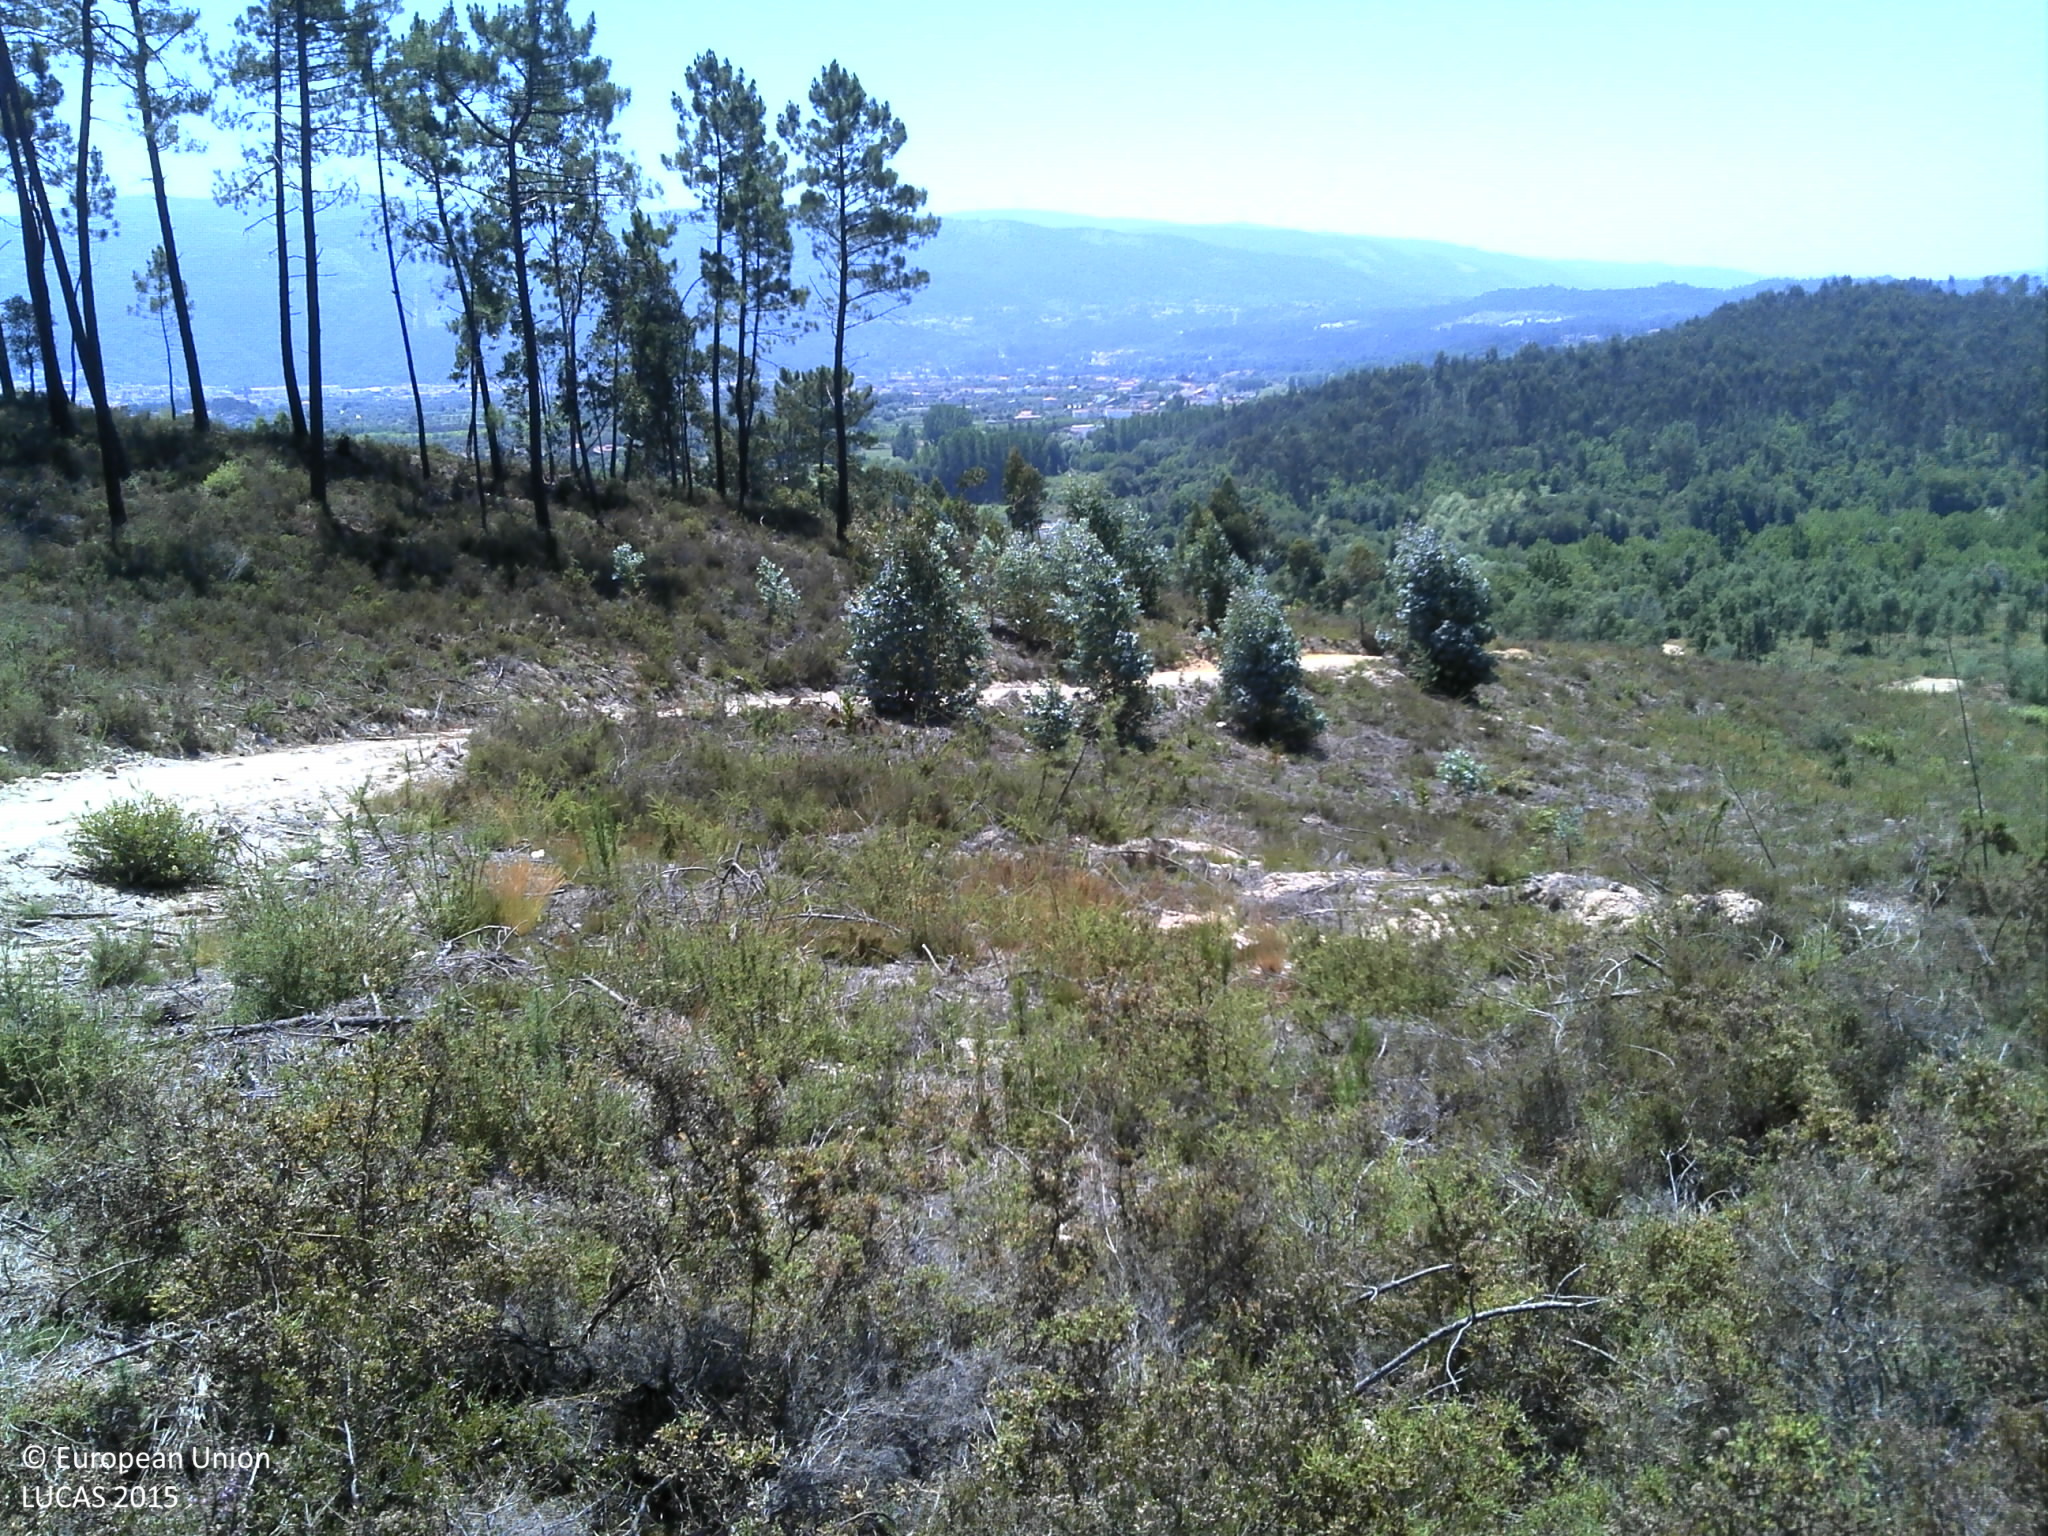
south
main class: Shrubland
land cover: Shrubland without tree cover
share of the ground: > 75 %
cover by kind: shrubs 90 %, unconsolidated bare surface 10 %
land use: Abandoned areas
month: June
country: PT
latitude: 40.1457
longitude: -8.2603
